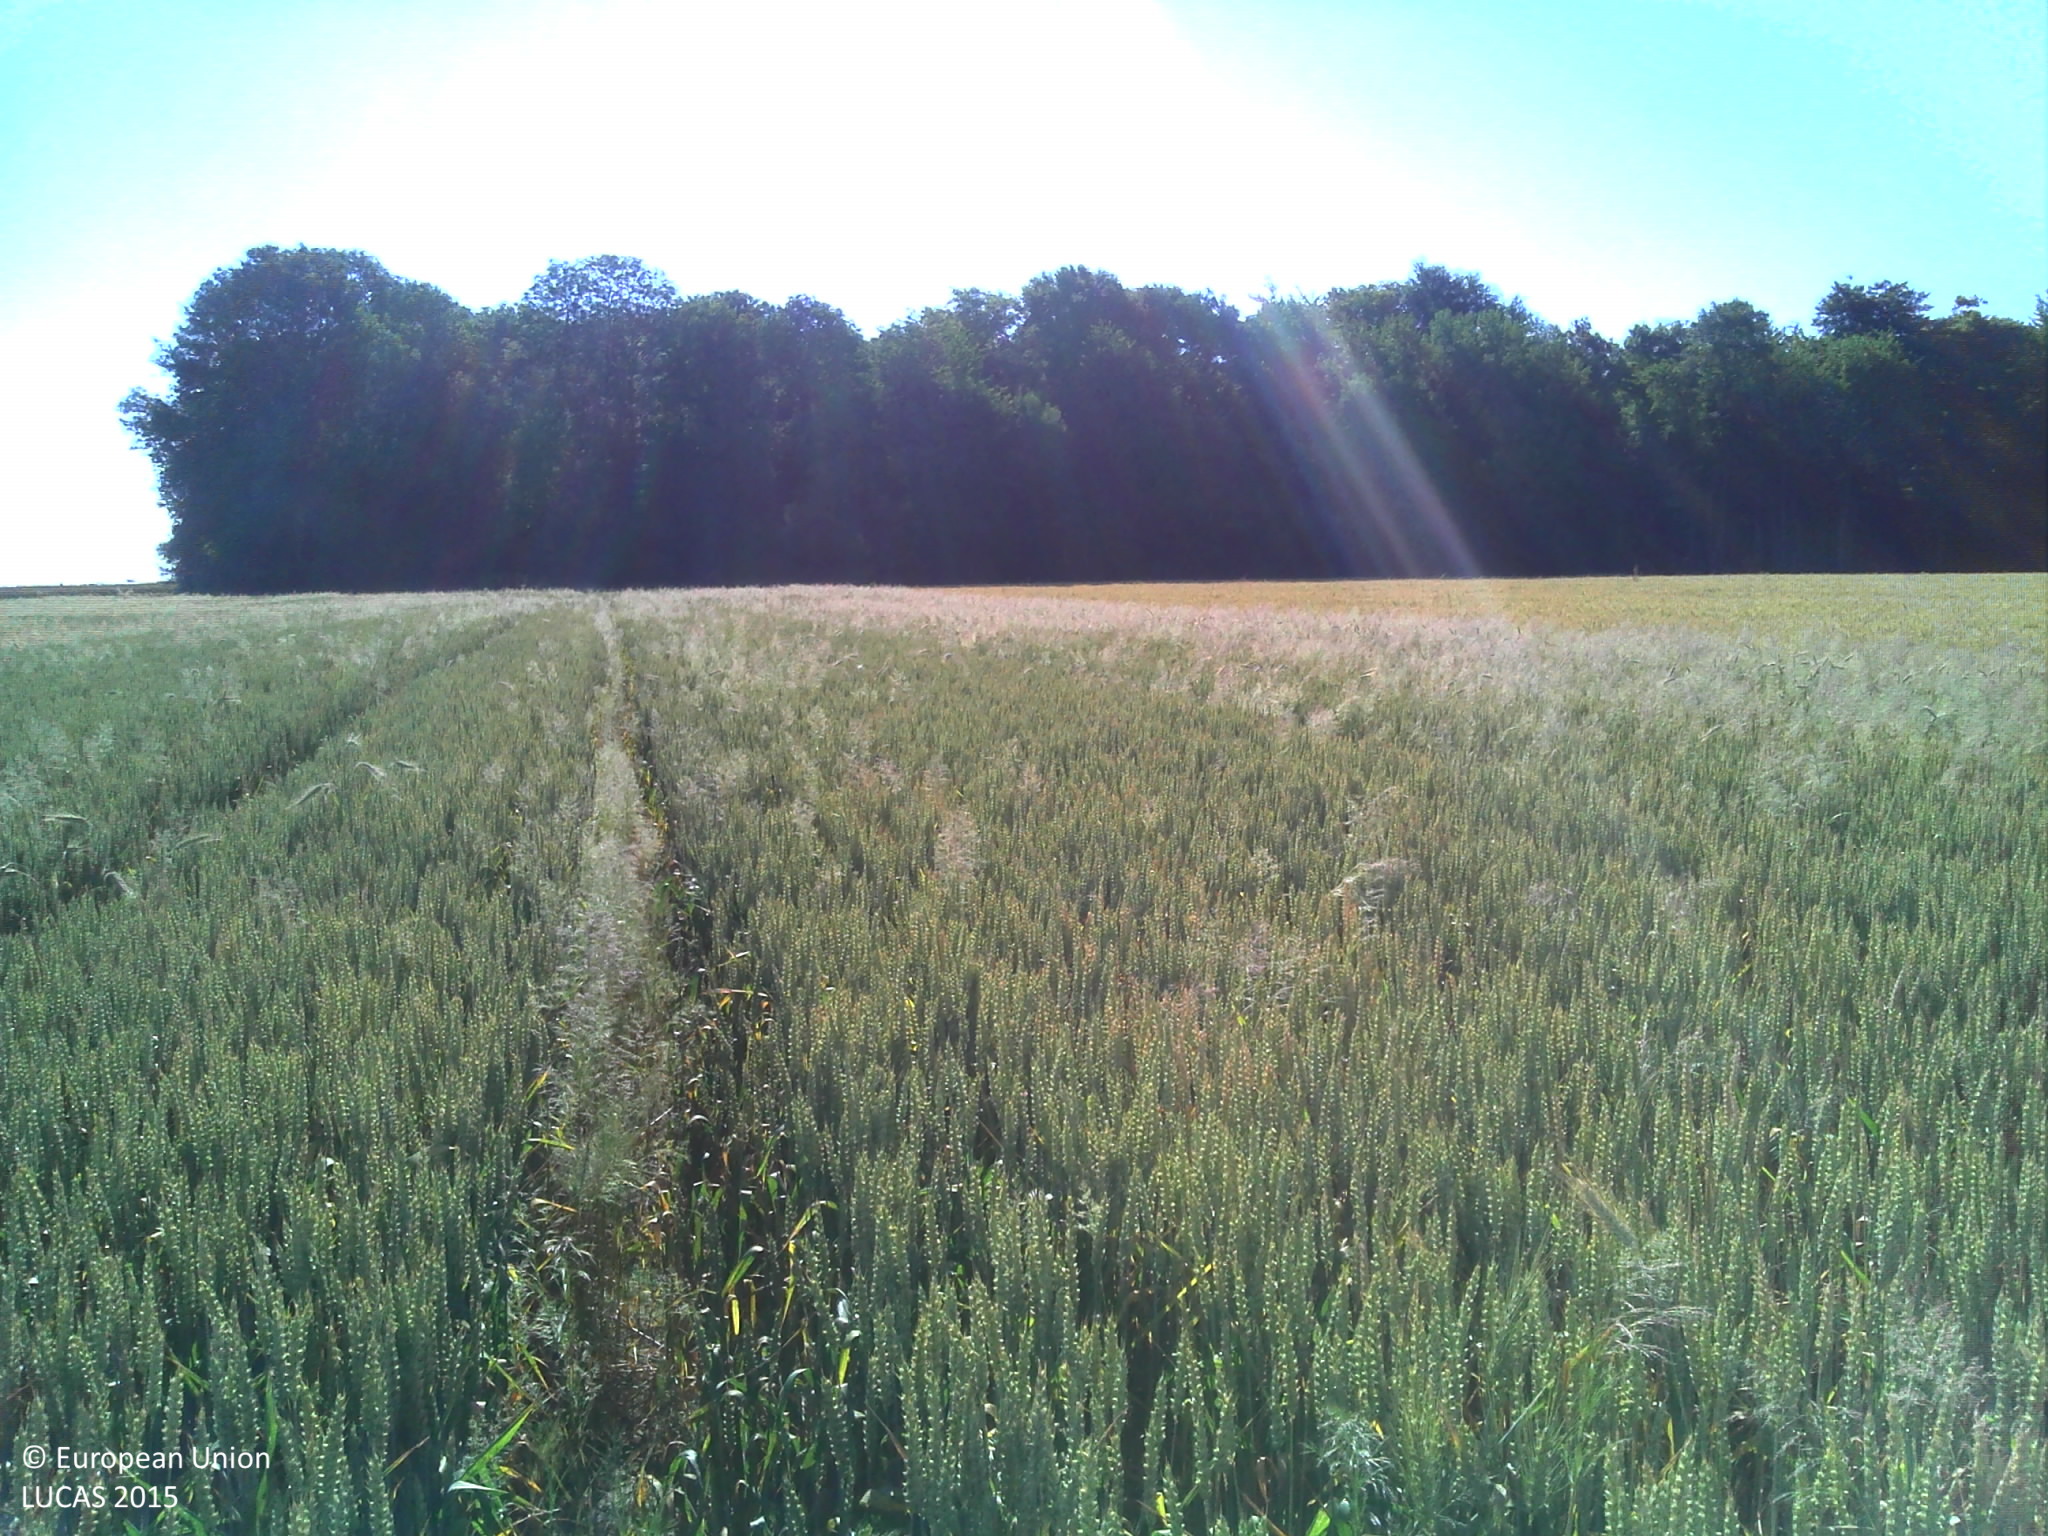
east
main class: Cropland
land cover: Common wheat
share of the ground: > 75 %
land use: Agriculture (excluding fallow land and kitchen gardens)
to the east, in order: Common wheat; Other bare soil; Shruby margins; Ditches and canals; Broadleaved woodland
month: July
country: FR
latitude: 48.5739
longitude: 6.2459
